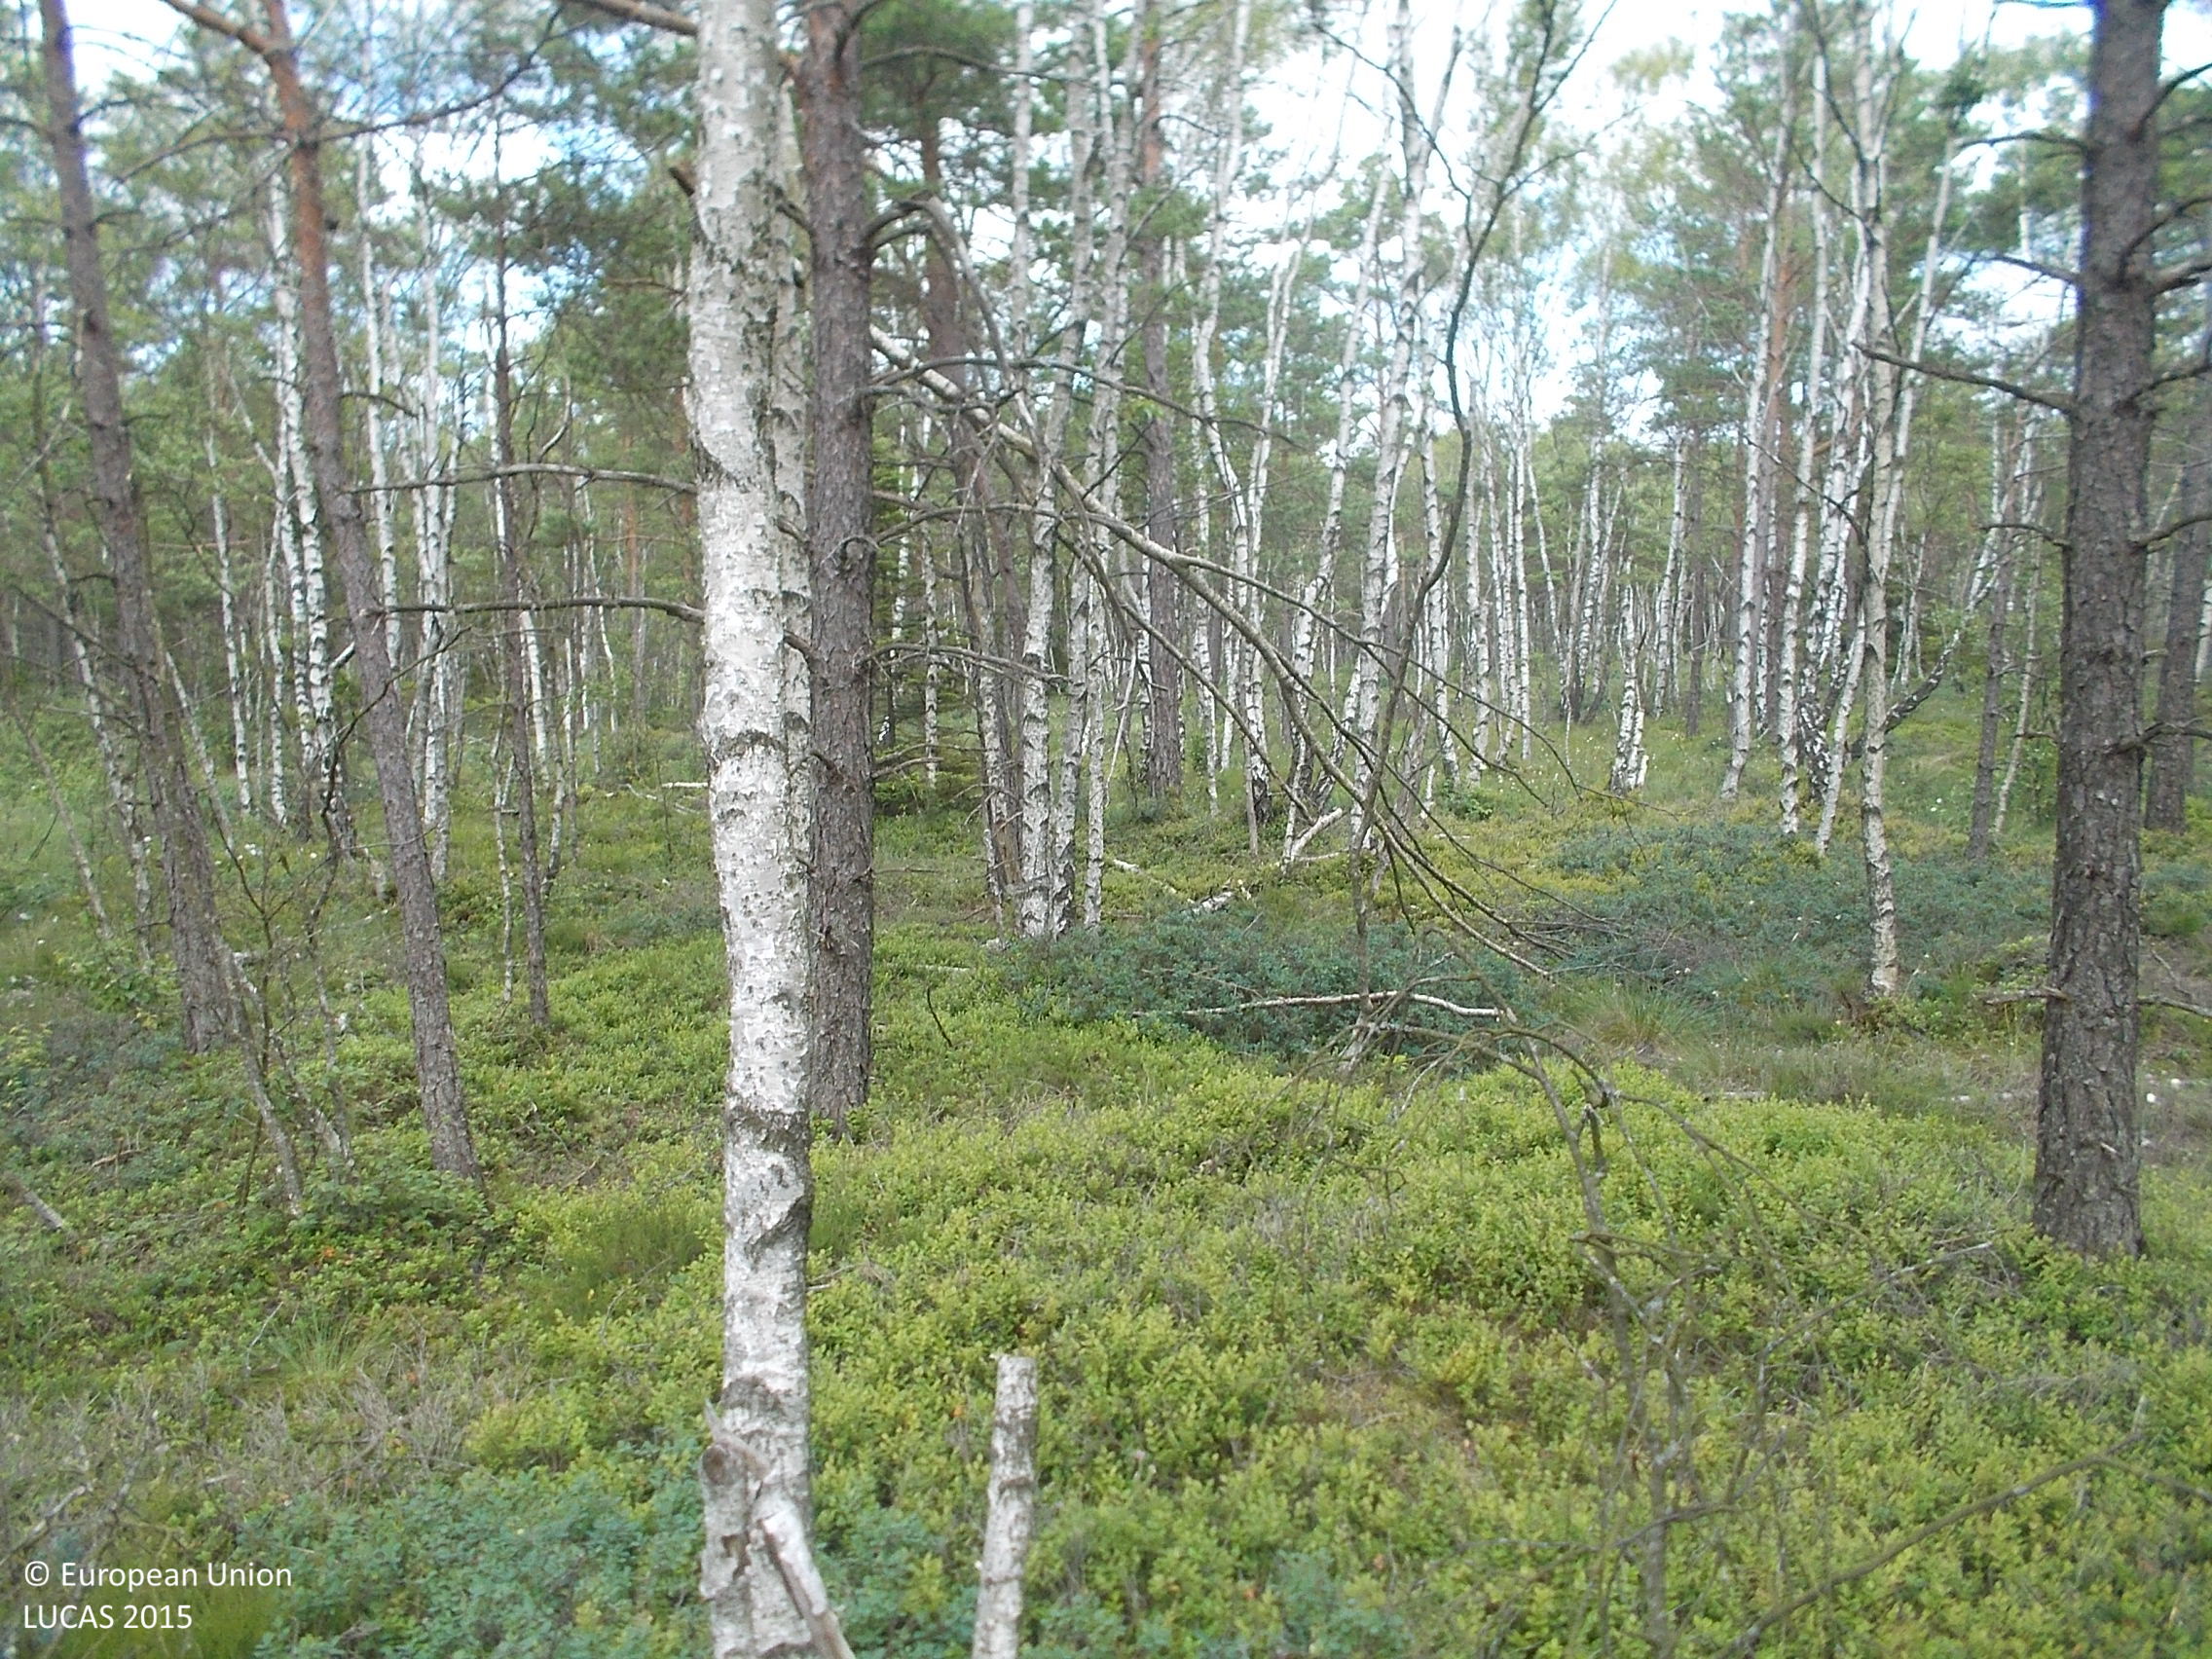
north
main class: Woodland
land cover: Pine dominated mixed woodland
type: boreal forest
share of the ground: 50 - 75 %
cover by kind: coniferous forest trees 40 %, broadleaved forest trees 35 %, shrubs 15 %, herbaceous plants 10 %
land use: Forestry
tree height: > 5 m
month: July
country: SE
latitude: 57.3912
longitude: 12.2427
